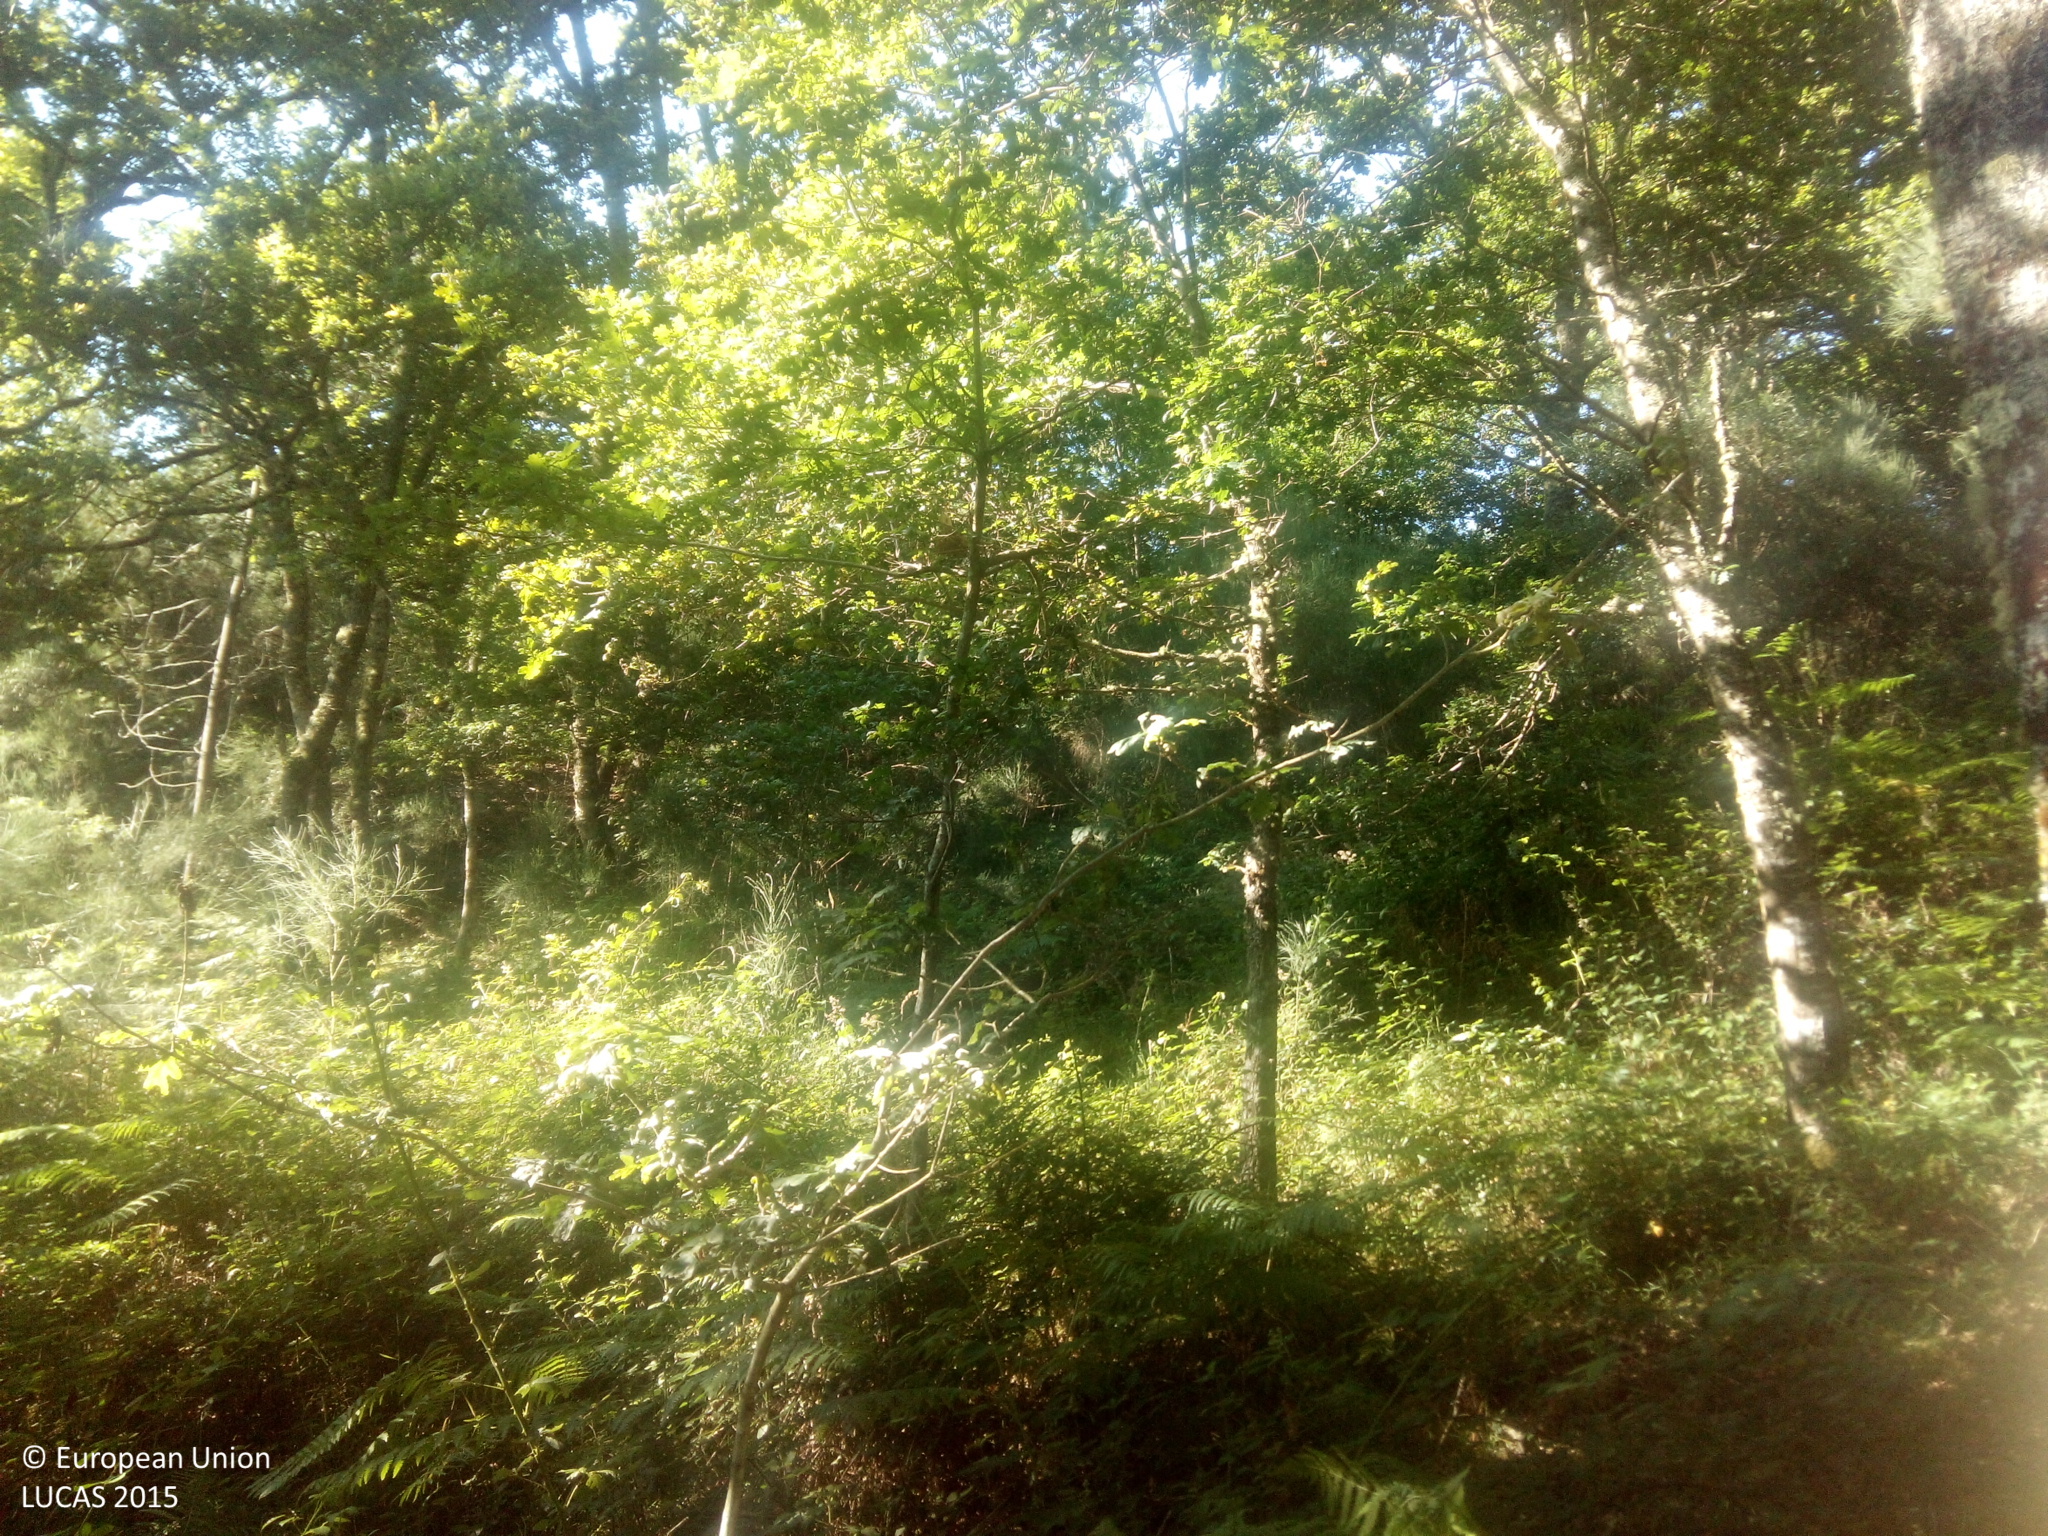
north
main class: Woodland
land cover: Broadleaved woodland
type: acidophilous oak and oak-birch forest
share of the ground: > 75 %
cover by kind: broadleaved forest trees 100 %
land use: Forestry
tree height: > 5 m
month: June
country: ES
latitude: 42.4313
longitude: -8.2871
